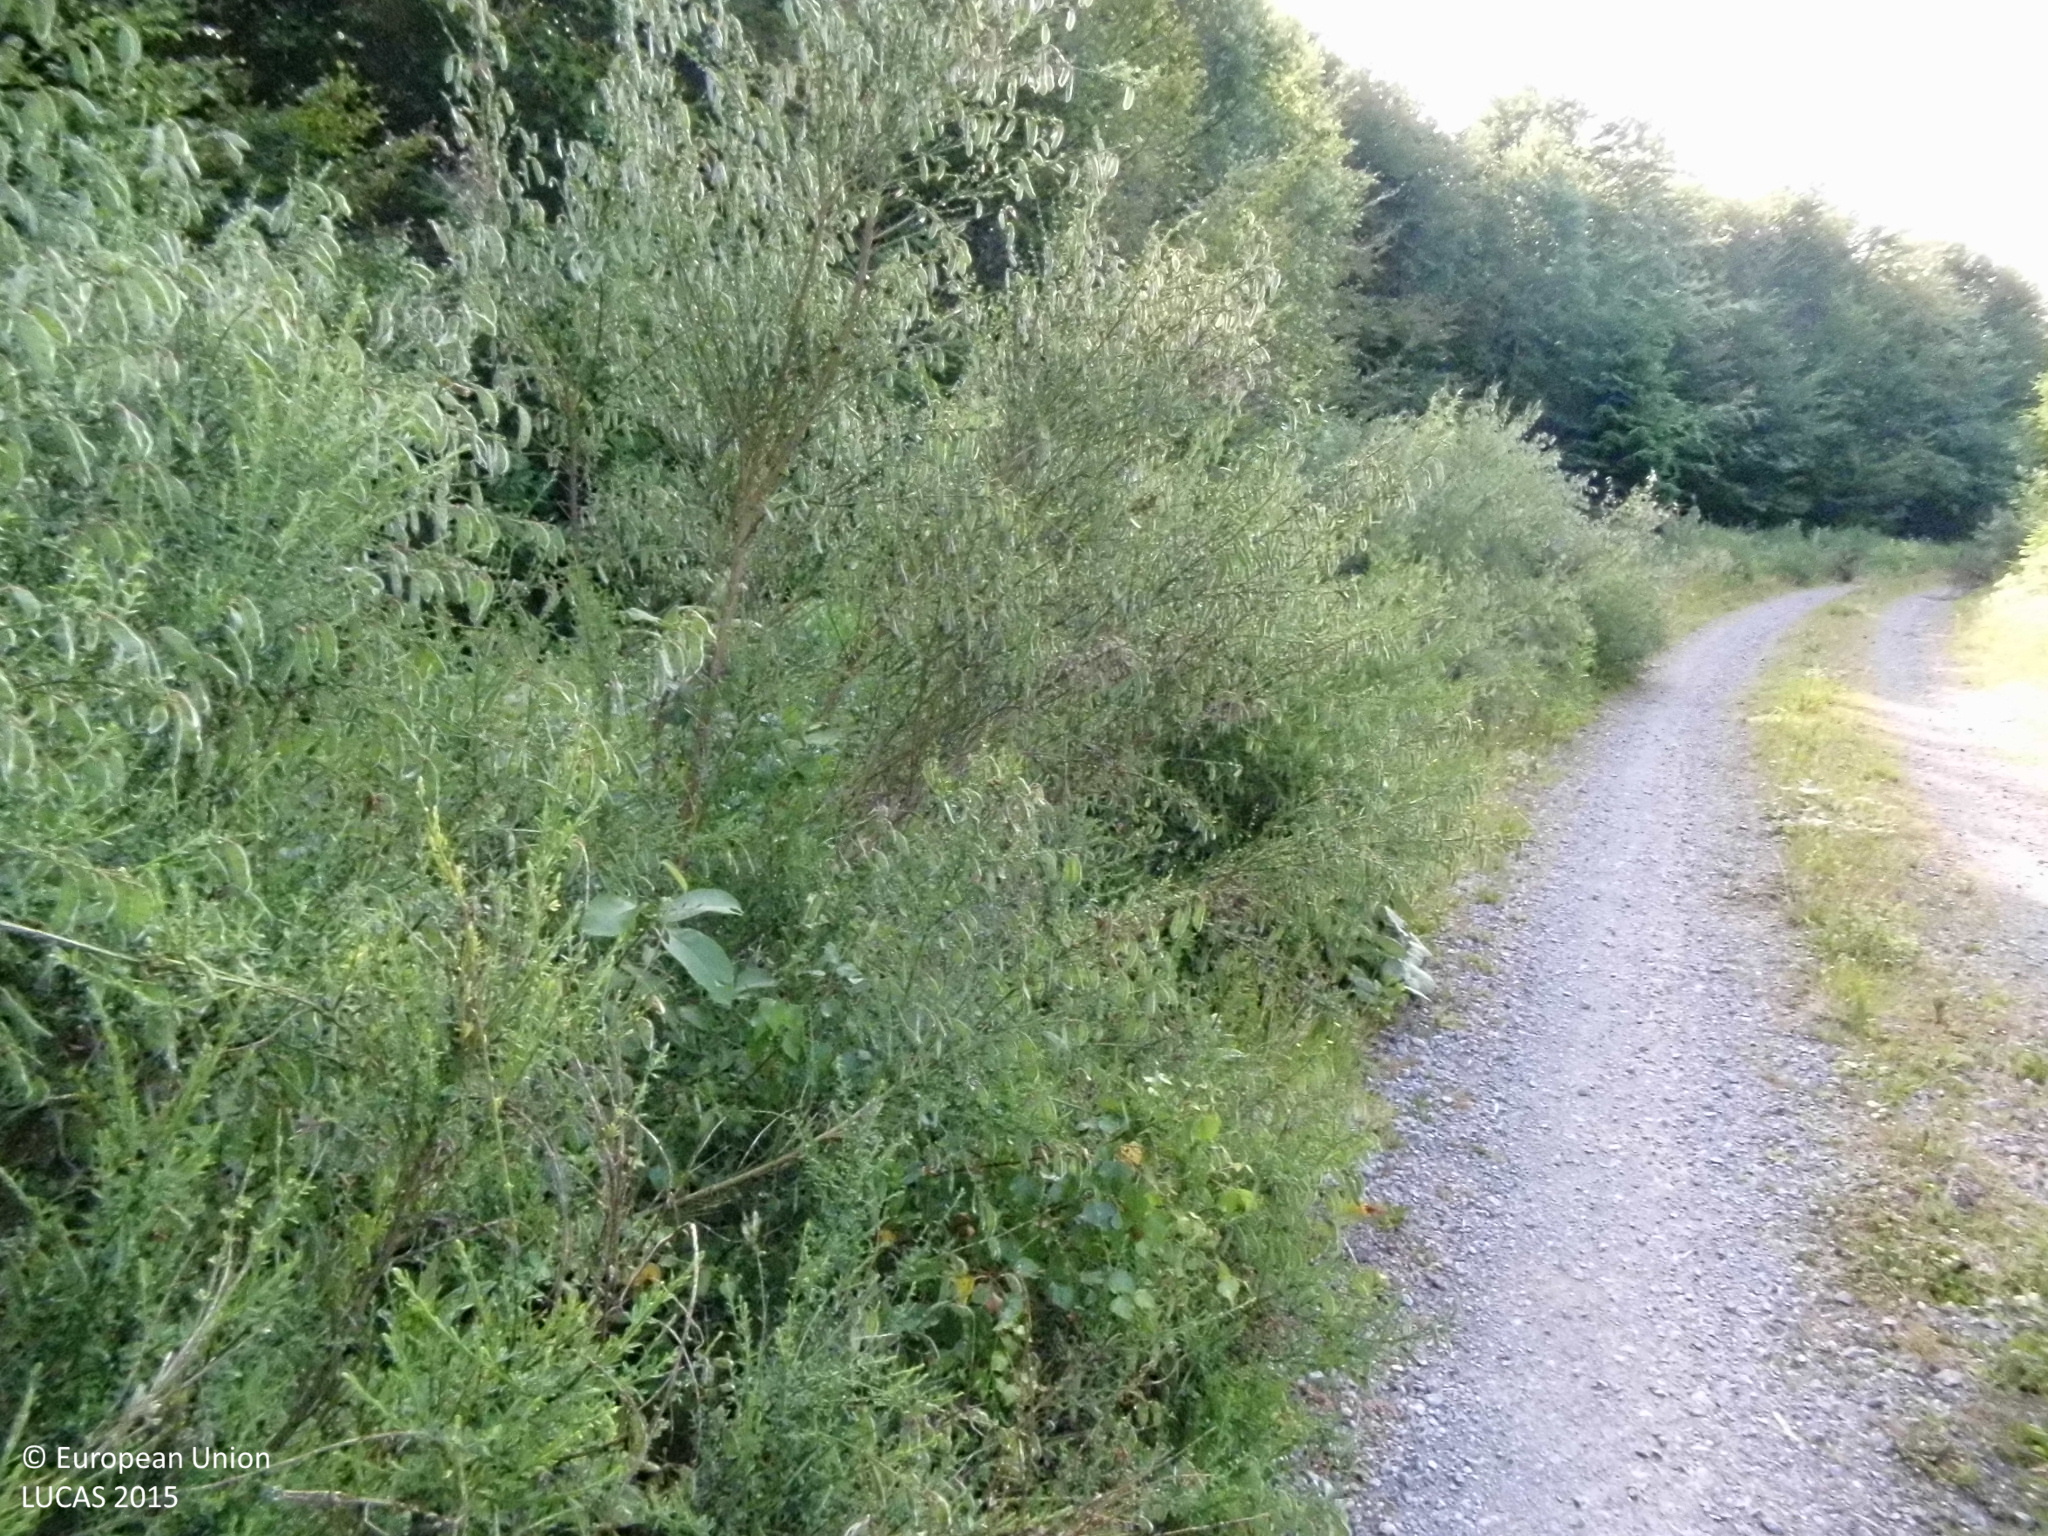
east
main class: Woodland
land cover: Broadleaved woodland
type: mesophytic deciduous forest
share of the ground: > 75 %
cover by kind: broadleaved forest trees 100 %
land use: Forestry
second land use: Amenities, museums, leisure
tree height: > 5 m
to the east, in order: Broadleaved woodland; Spruce dominated coniferous woodland; Lichens and moss; Tracks; Spruce dominated coniferous woodland; Grassland without tree/shrub cover; Spruce dominated coniferous woodland; Grassland without tree/shrub cover; Broadleaved woodland; Spruce dominated coniferous woodland
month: July
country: DE
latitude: 51.2639
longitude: 8.0083
